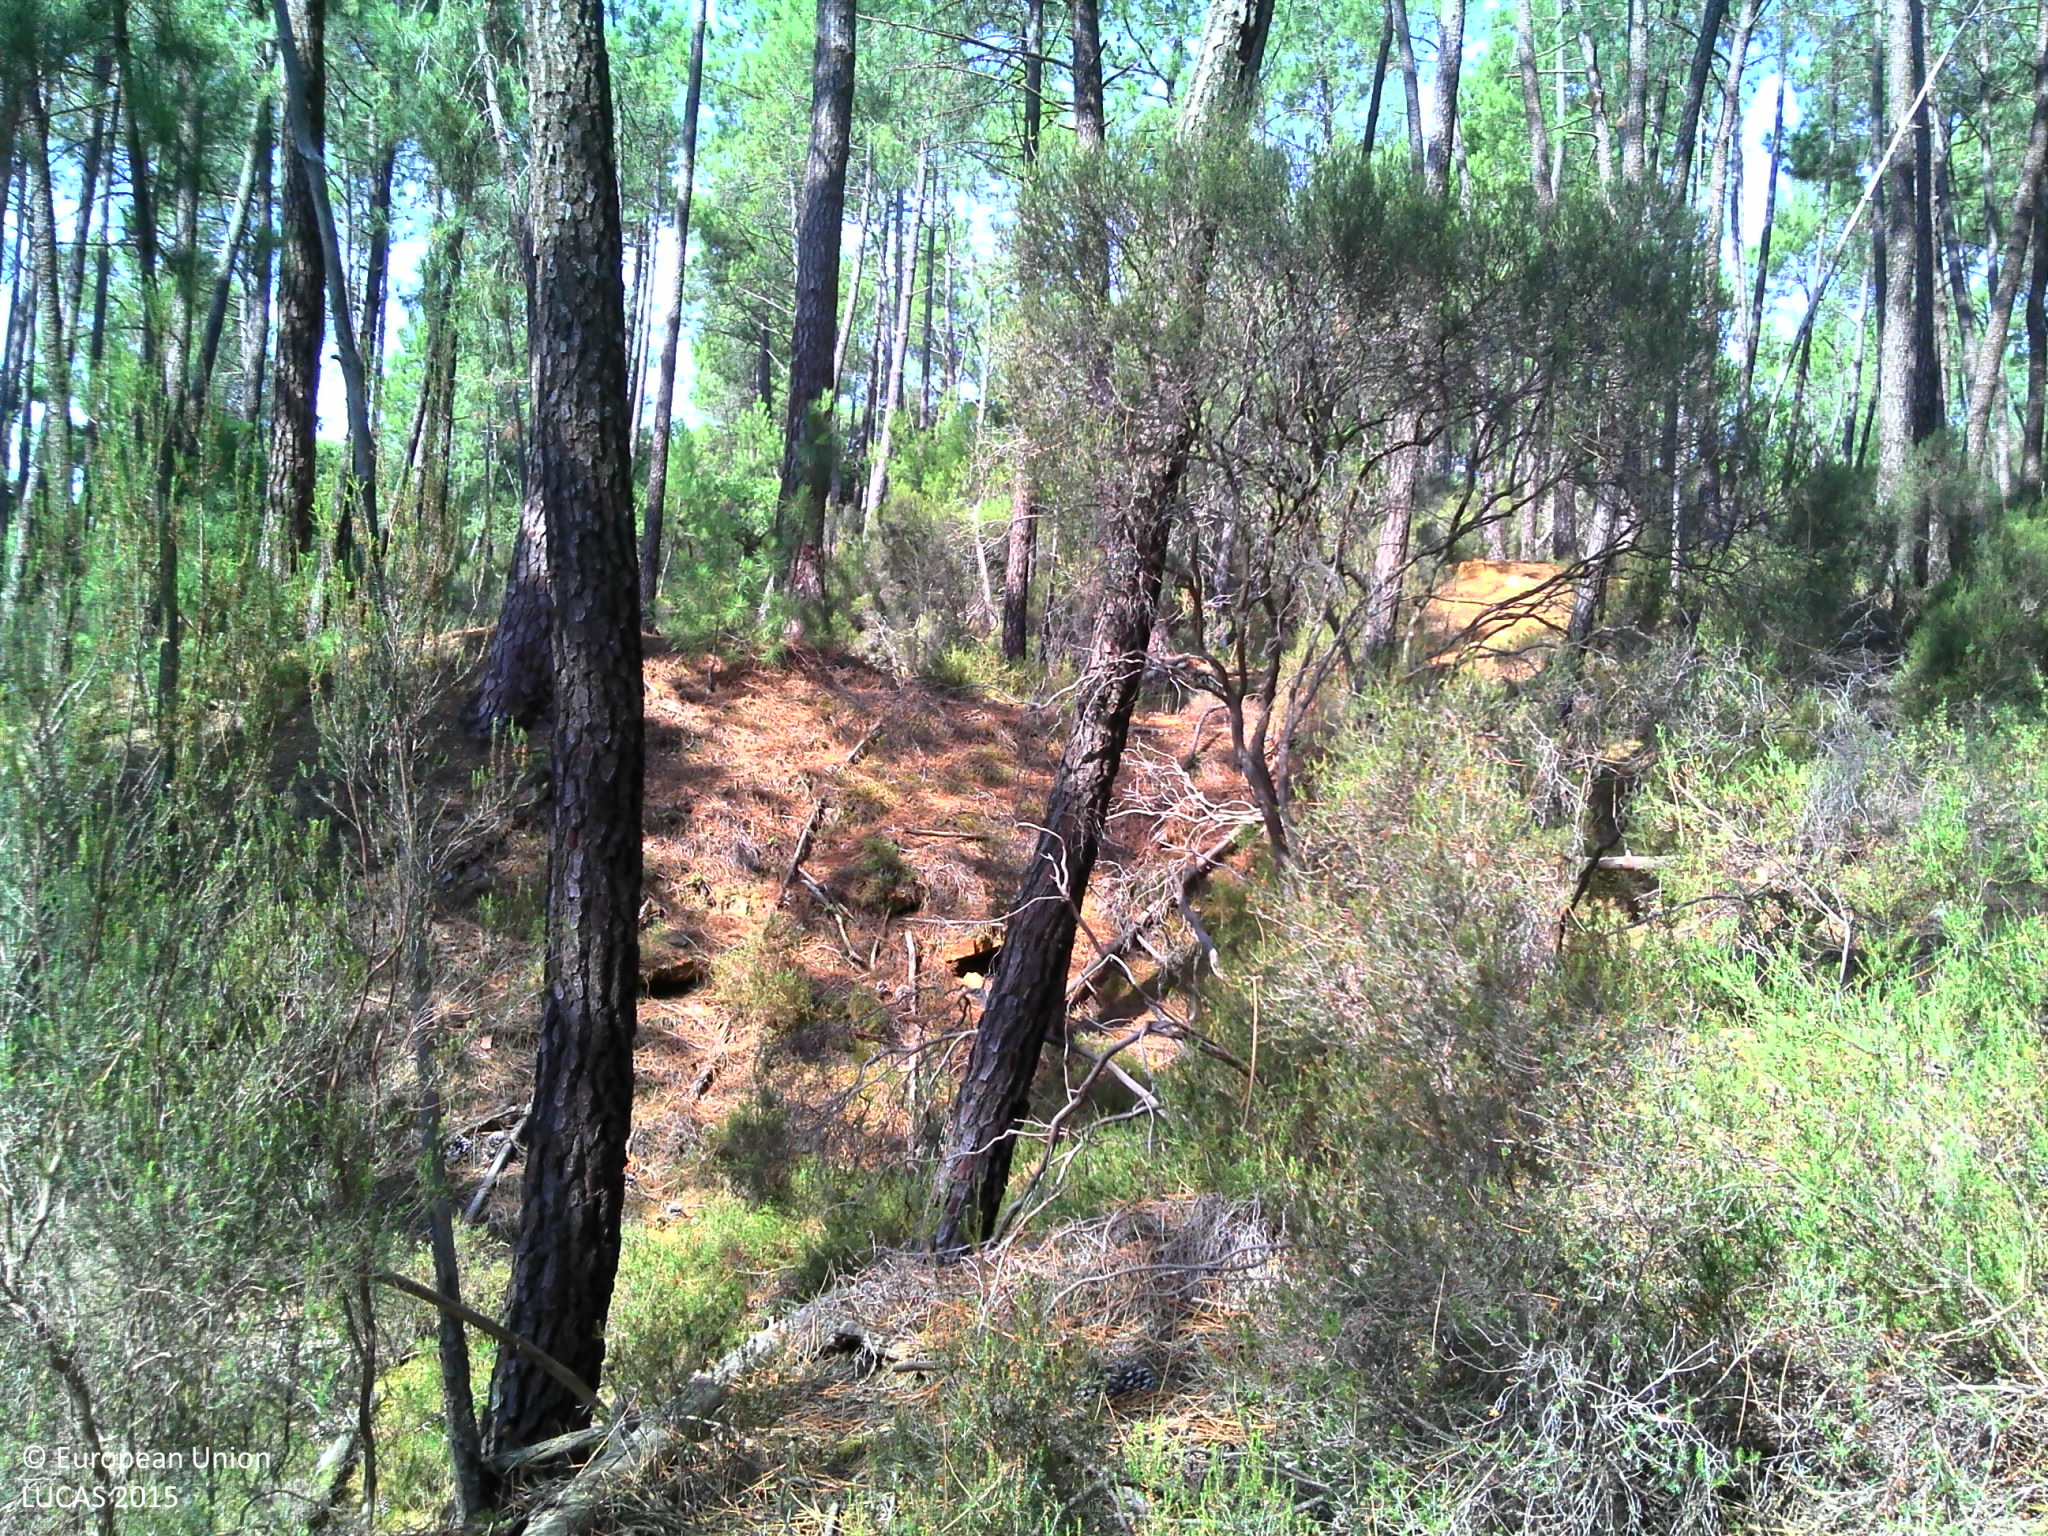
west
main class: Woodland
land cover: Pine dominated coniferous woodland
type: coniferous forest of the mediterranean region
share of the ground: > 75 %
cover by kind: coniferous forest trees 75 %, shrubs 15 %, herbaceous plants 10 %
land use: Forestry
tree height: > 5 m
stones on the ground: 10 - 25 %
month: July
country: FR
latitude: 44.0781
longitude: 5.2256
